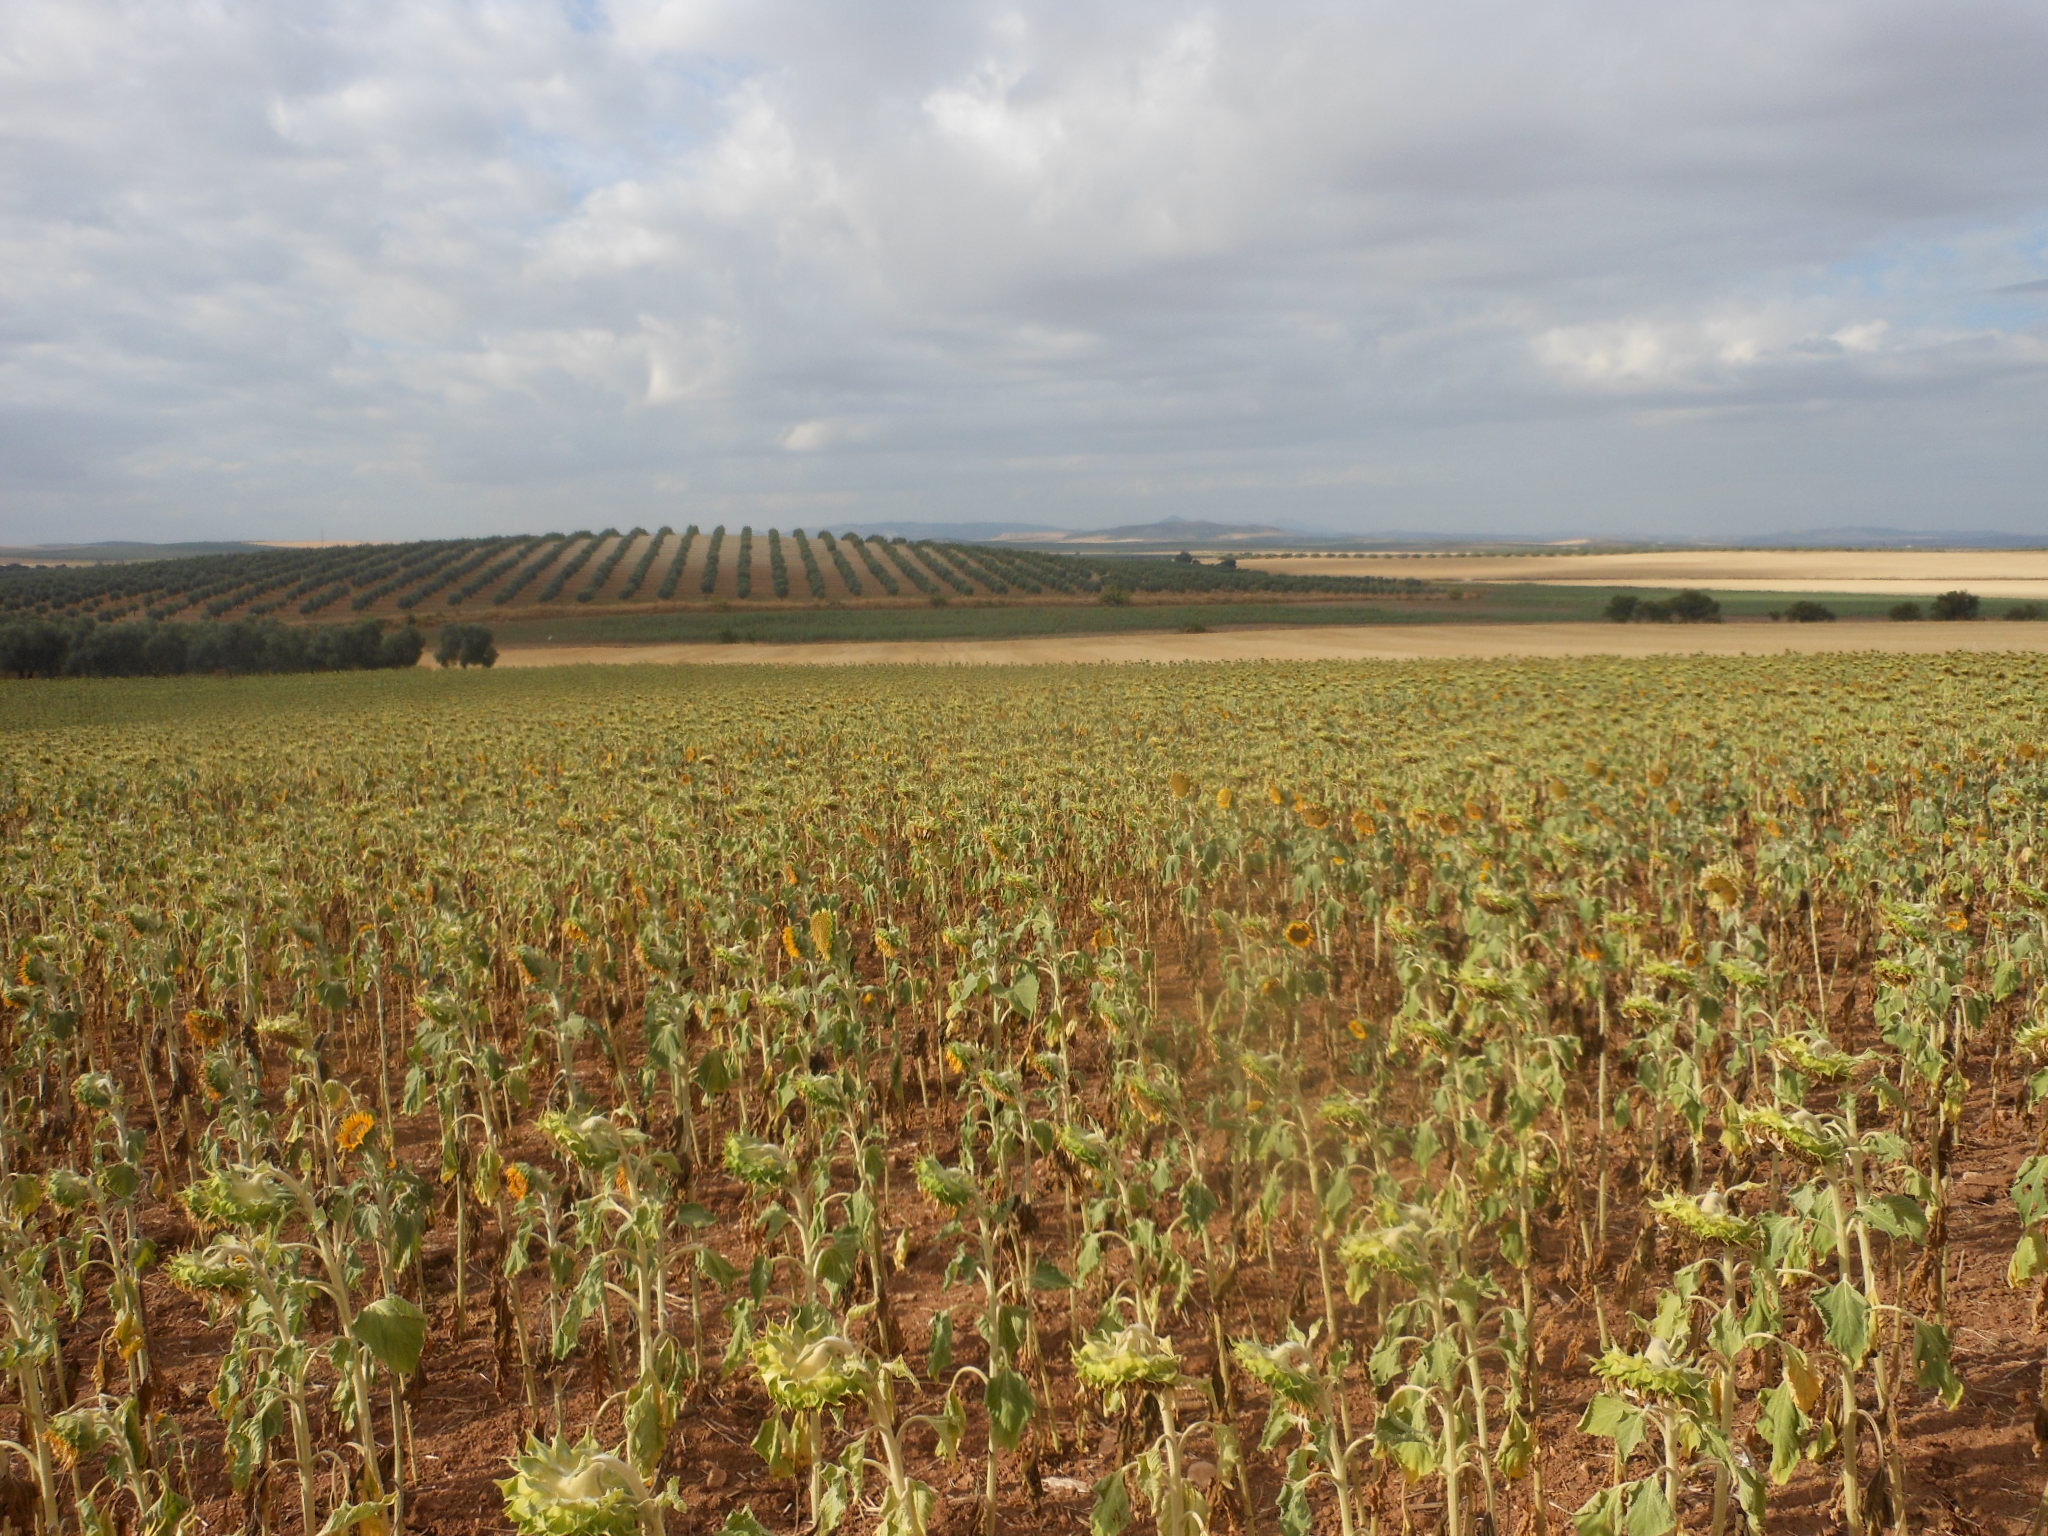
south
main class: Cropland
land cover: Sunflower
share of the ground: 50 - 75 %
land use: Agriculture (excluding fallow land and kitchen gardens)
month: June
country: ES
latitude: 37.3298
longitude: -5.0755
